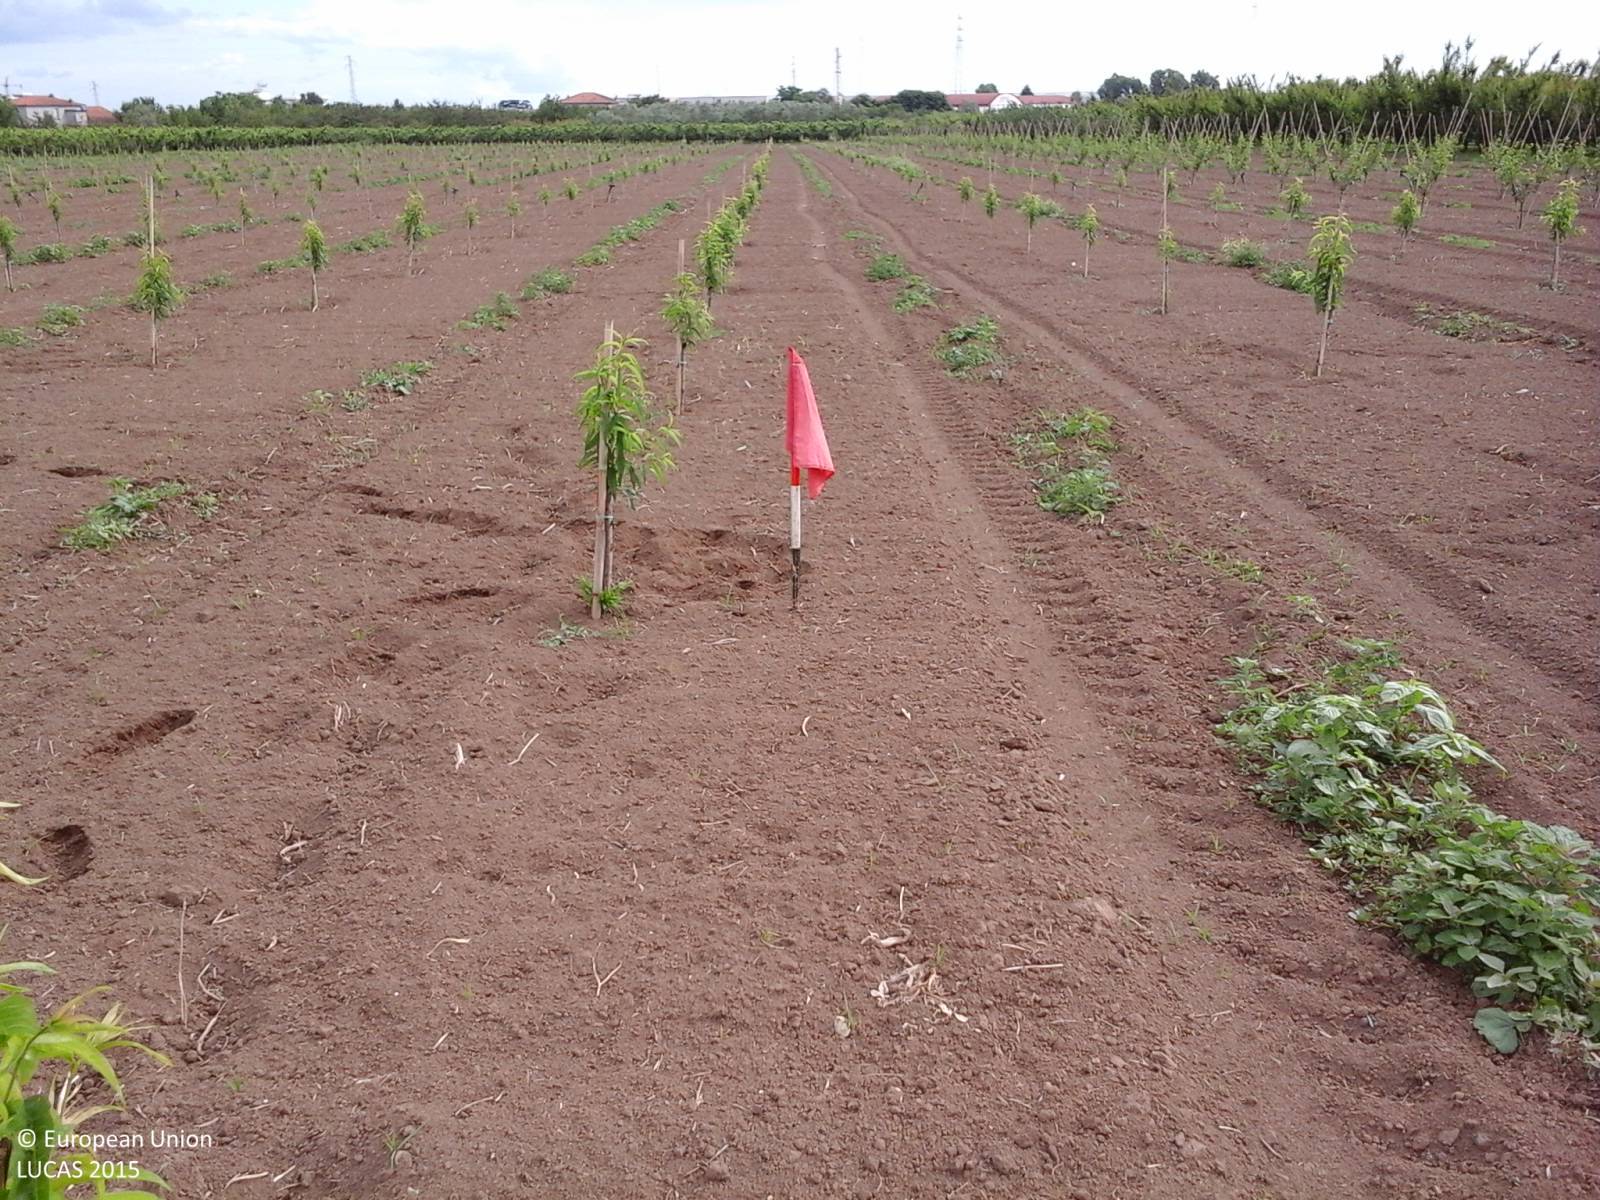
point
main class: Cropland
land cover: Other fruit trees and berries
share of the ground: < 10 %
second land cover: Other bare soil
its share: > 75 %
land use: Agriculture (excluding fallow land and kitchen gardens)
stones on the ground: < 10 %
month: May
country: IT
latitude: 41.1751
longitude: 14.1675
